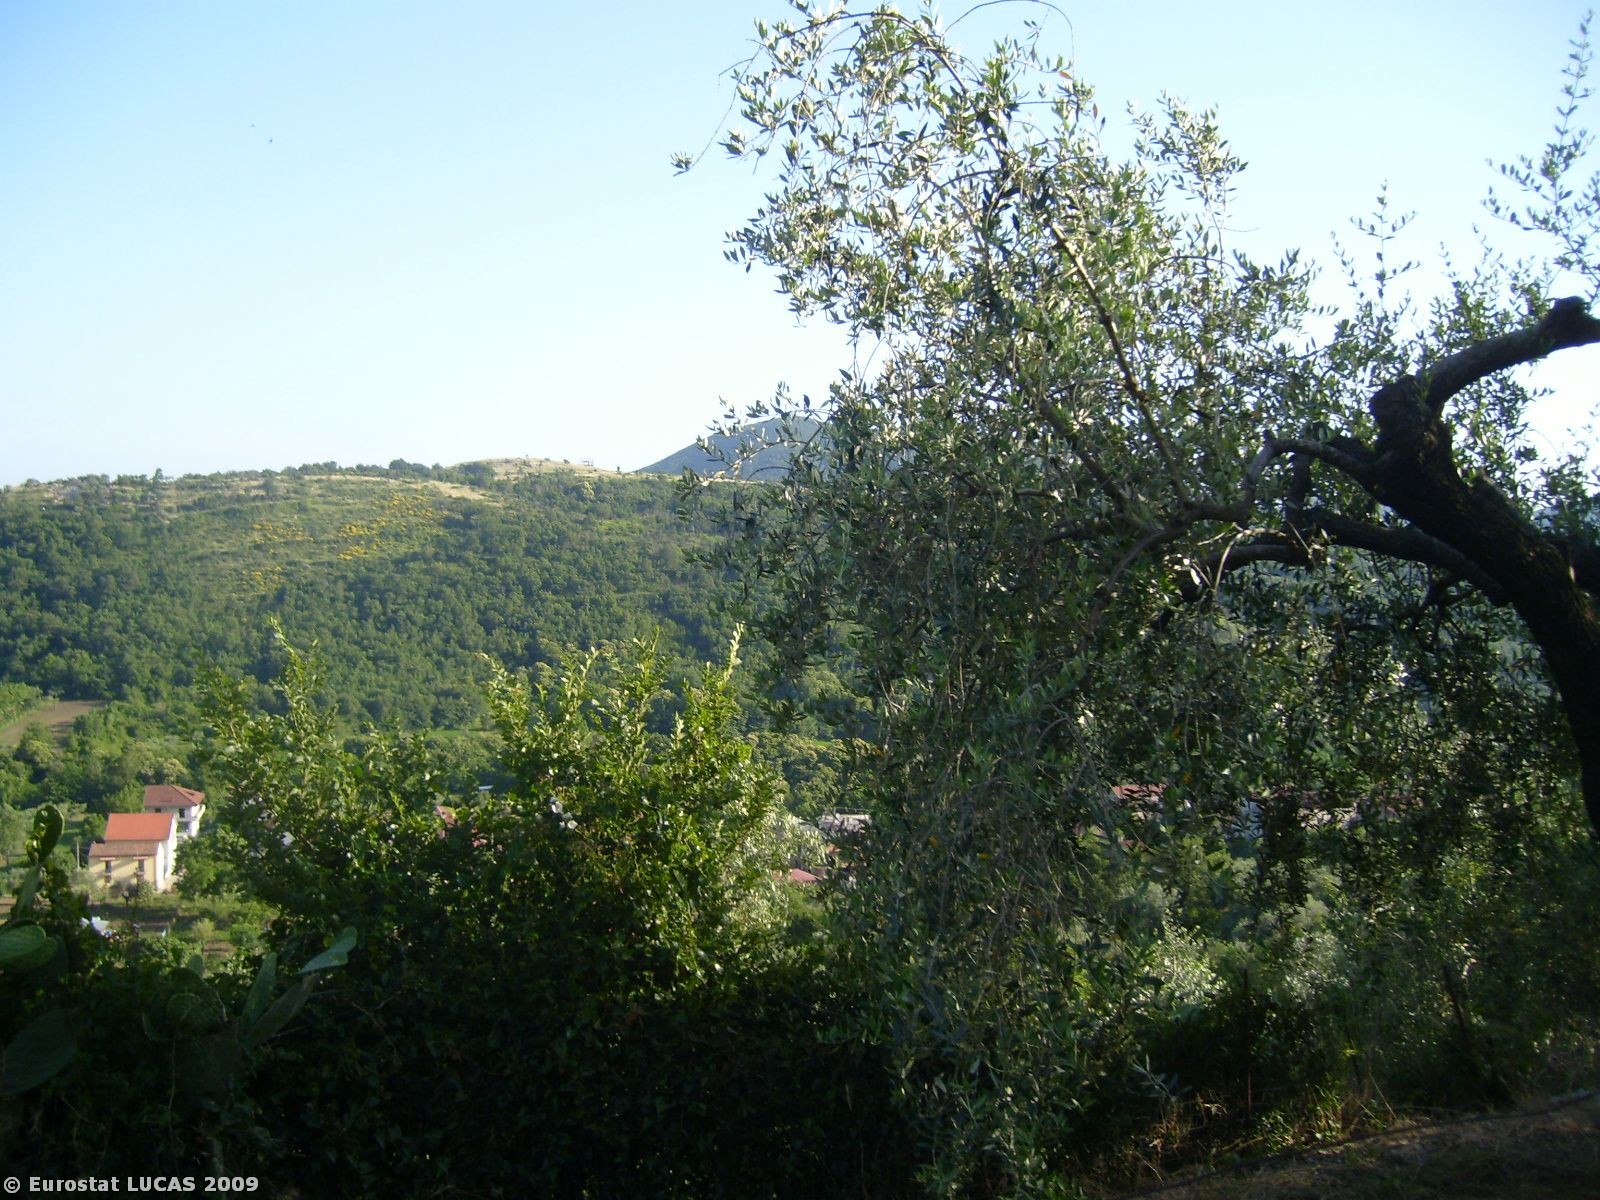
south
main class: Shrubland
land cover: Shrubland with sparse tree cover
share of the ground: > 75 %
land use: Fallow land
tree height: < 5 m
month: June
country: IT
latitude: 41.1319
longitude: 14.3310
